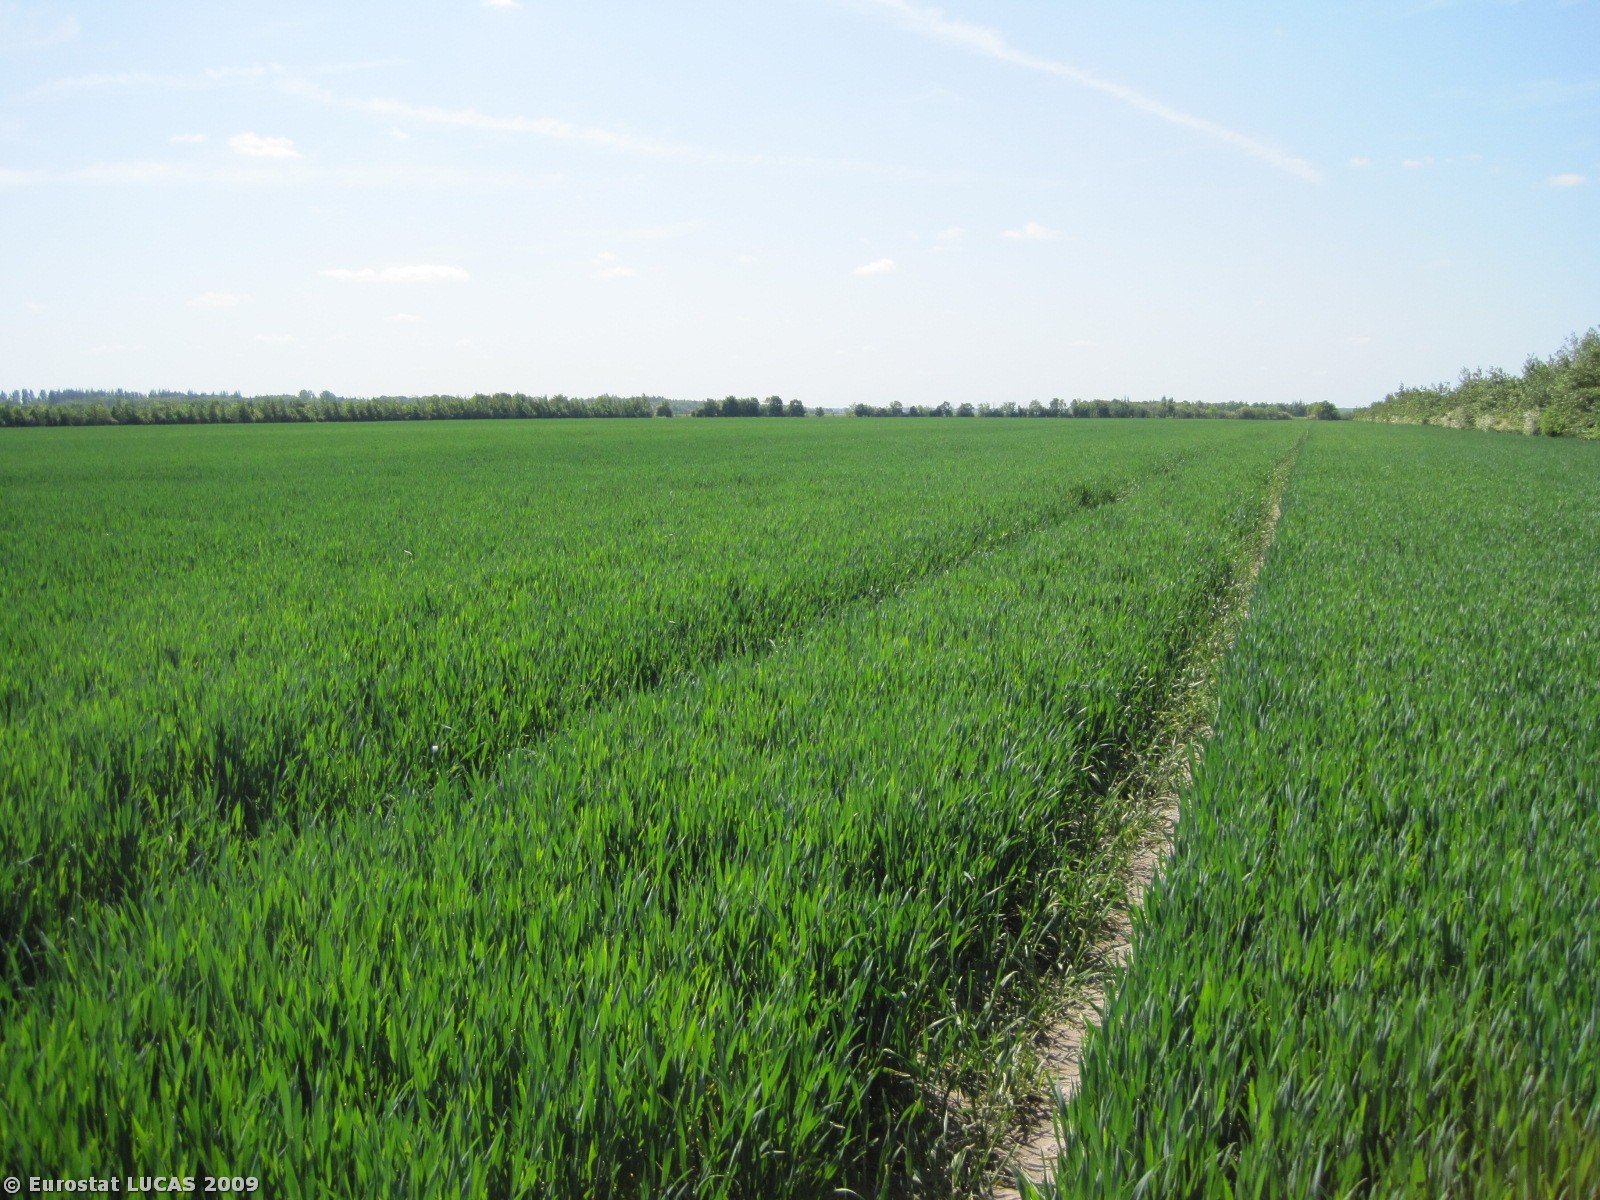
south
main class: Cropland
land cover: Common wheat
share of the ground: > 75 %
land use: Agriculture (excluding fallow land and kitchen gardens)
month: May
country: DK
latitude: 56.5470
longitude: 10.2437
